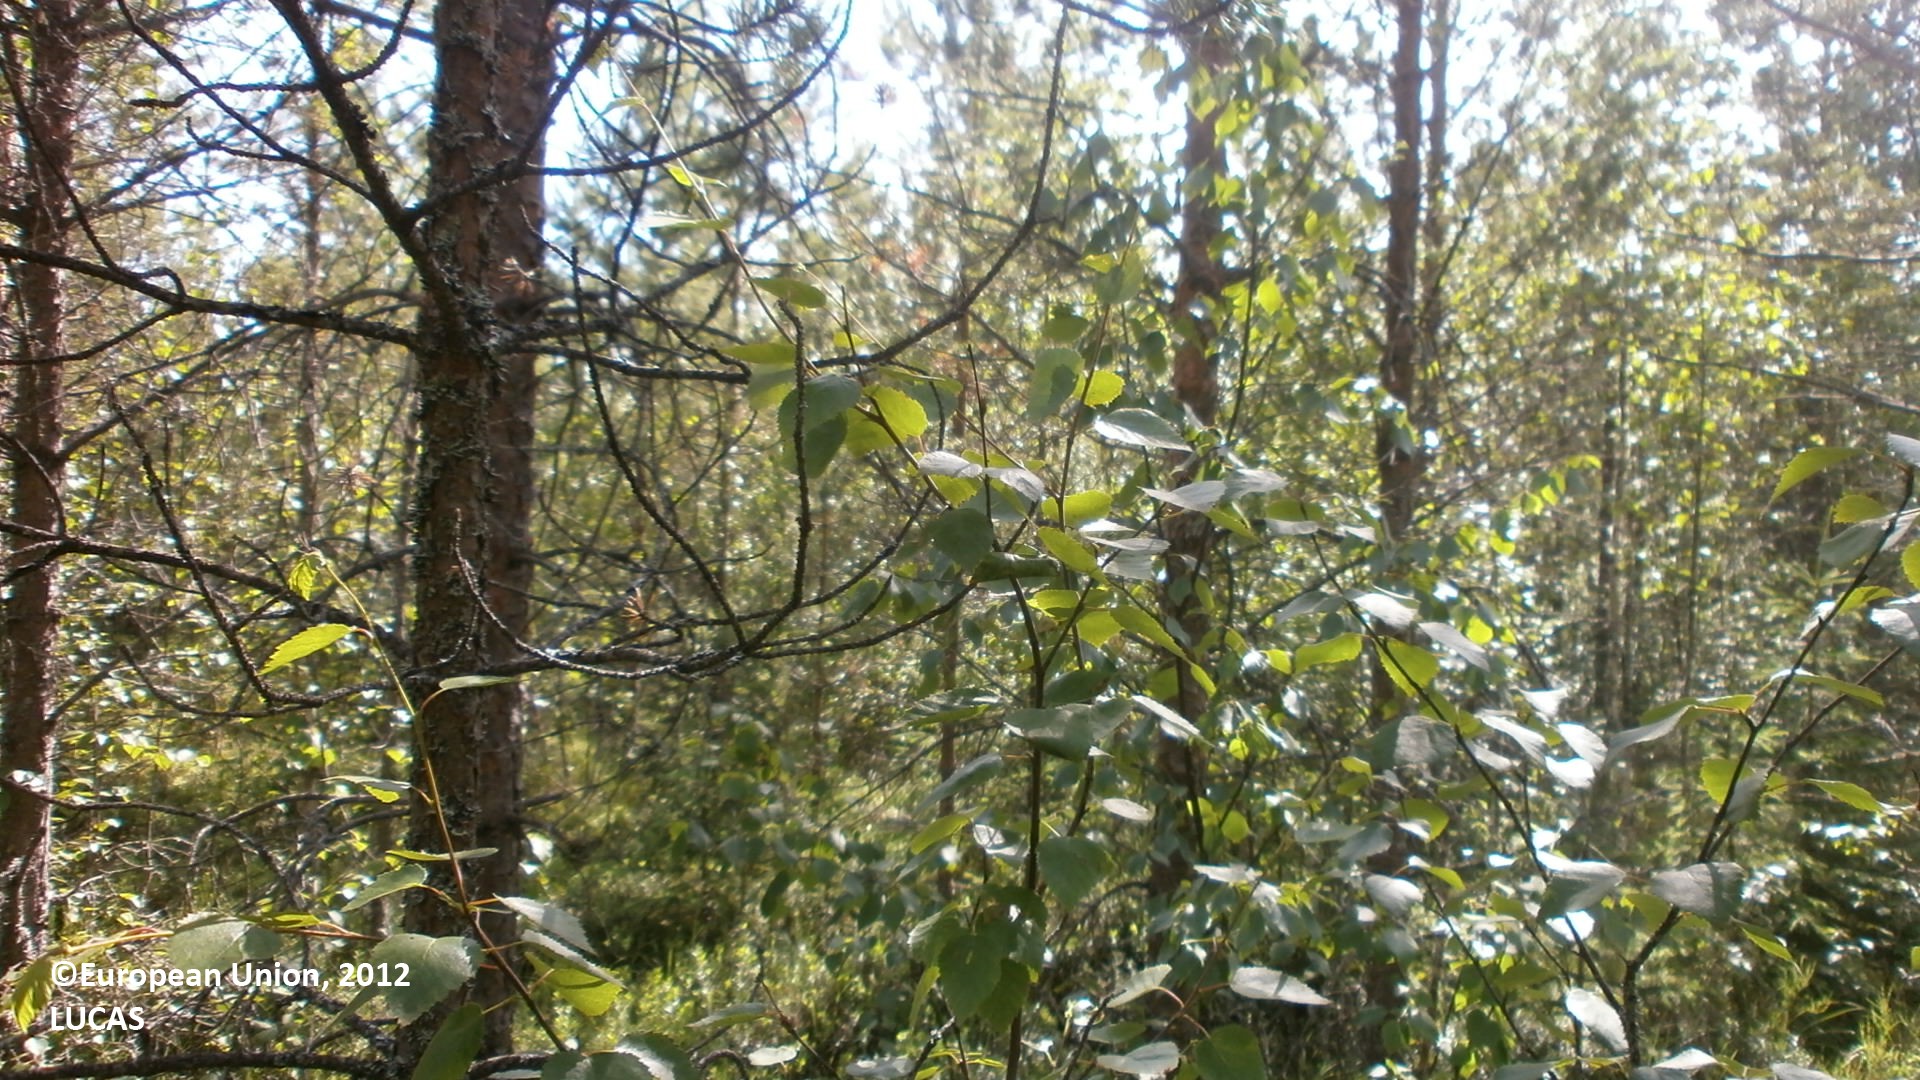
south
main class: Woodland
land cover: Pine dominated mixed woodland
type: boreal forest
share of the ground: 50 - 75 %
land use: Forestry
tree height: > 5 m
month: July
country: FI
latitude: 64.2489
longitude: 24.2395
